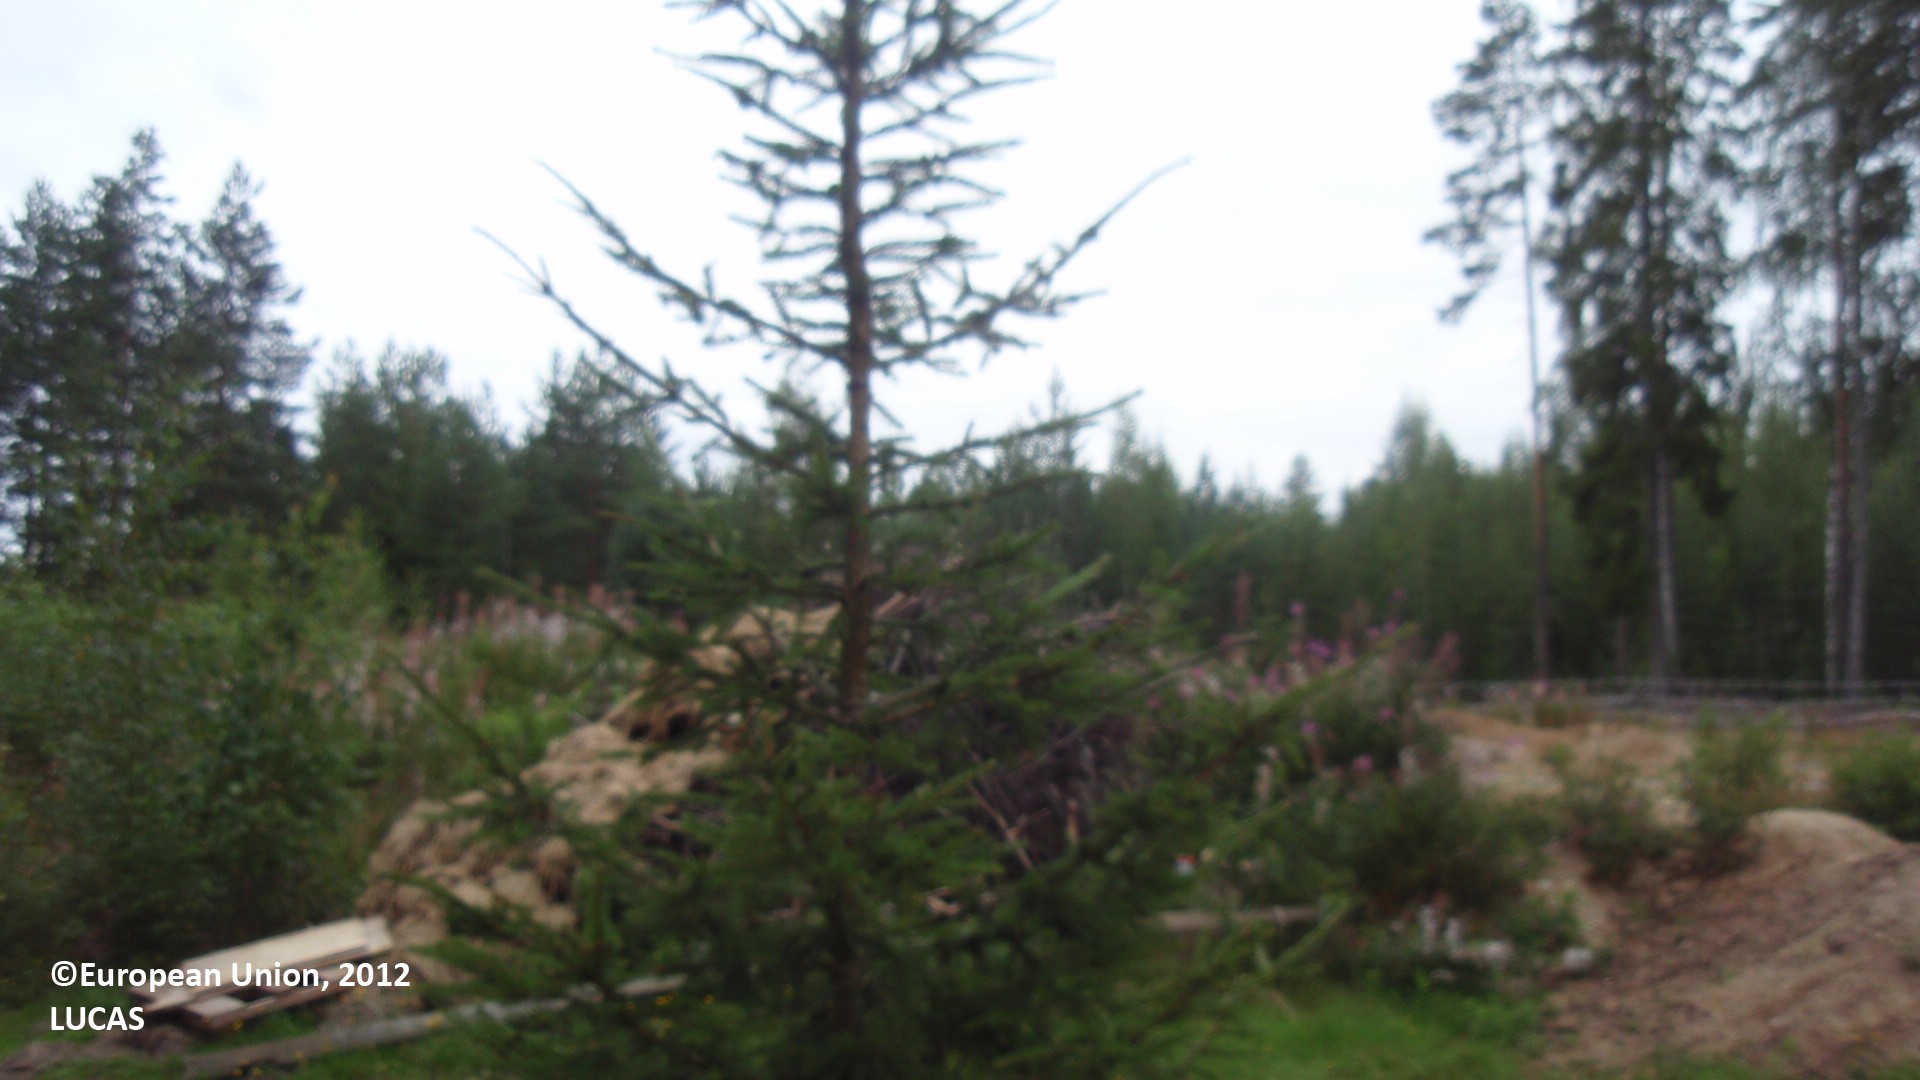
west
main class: Grassland
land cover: Spontaneously vegetated surfaces
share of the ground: > 75 %
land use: Fallow land
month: August
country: FI
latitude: 61.2847
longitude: 27.5905
